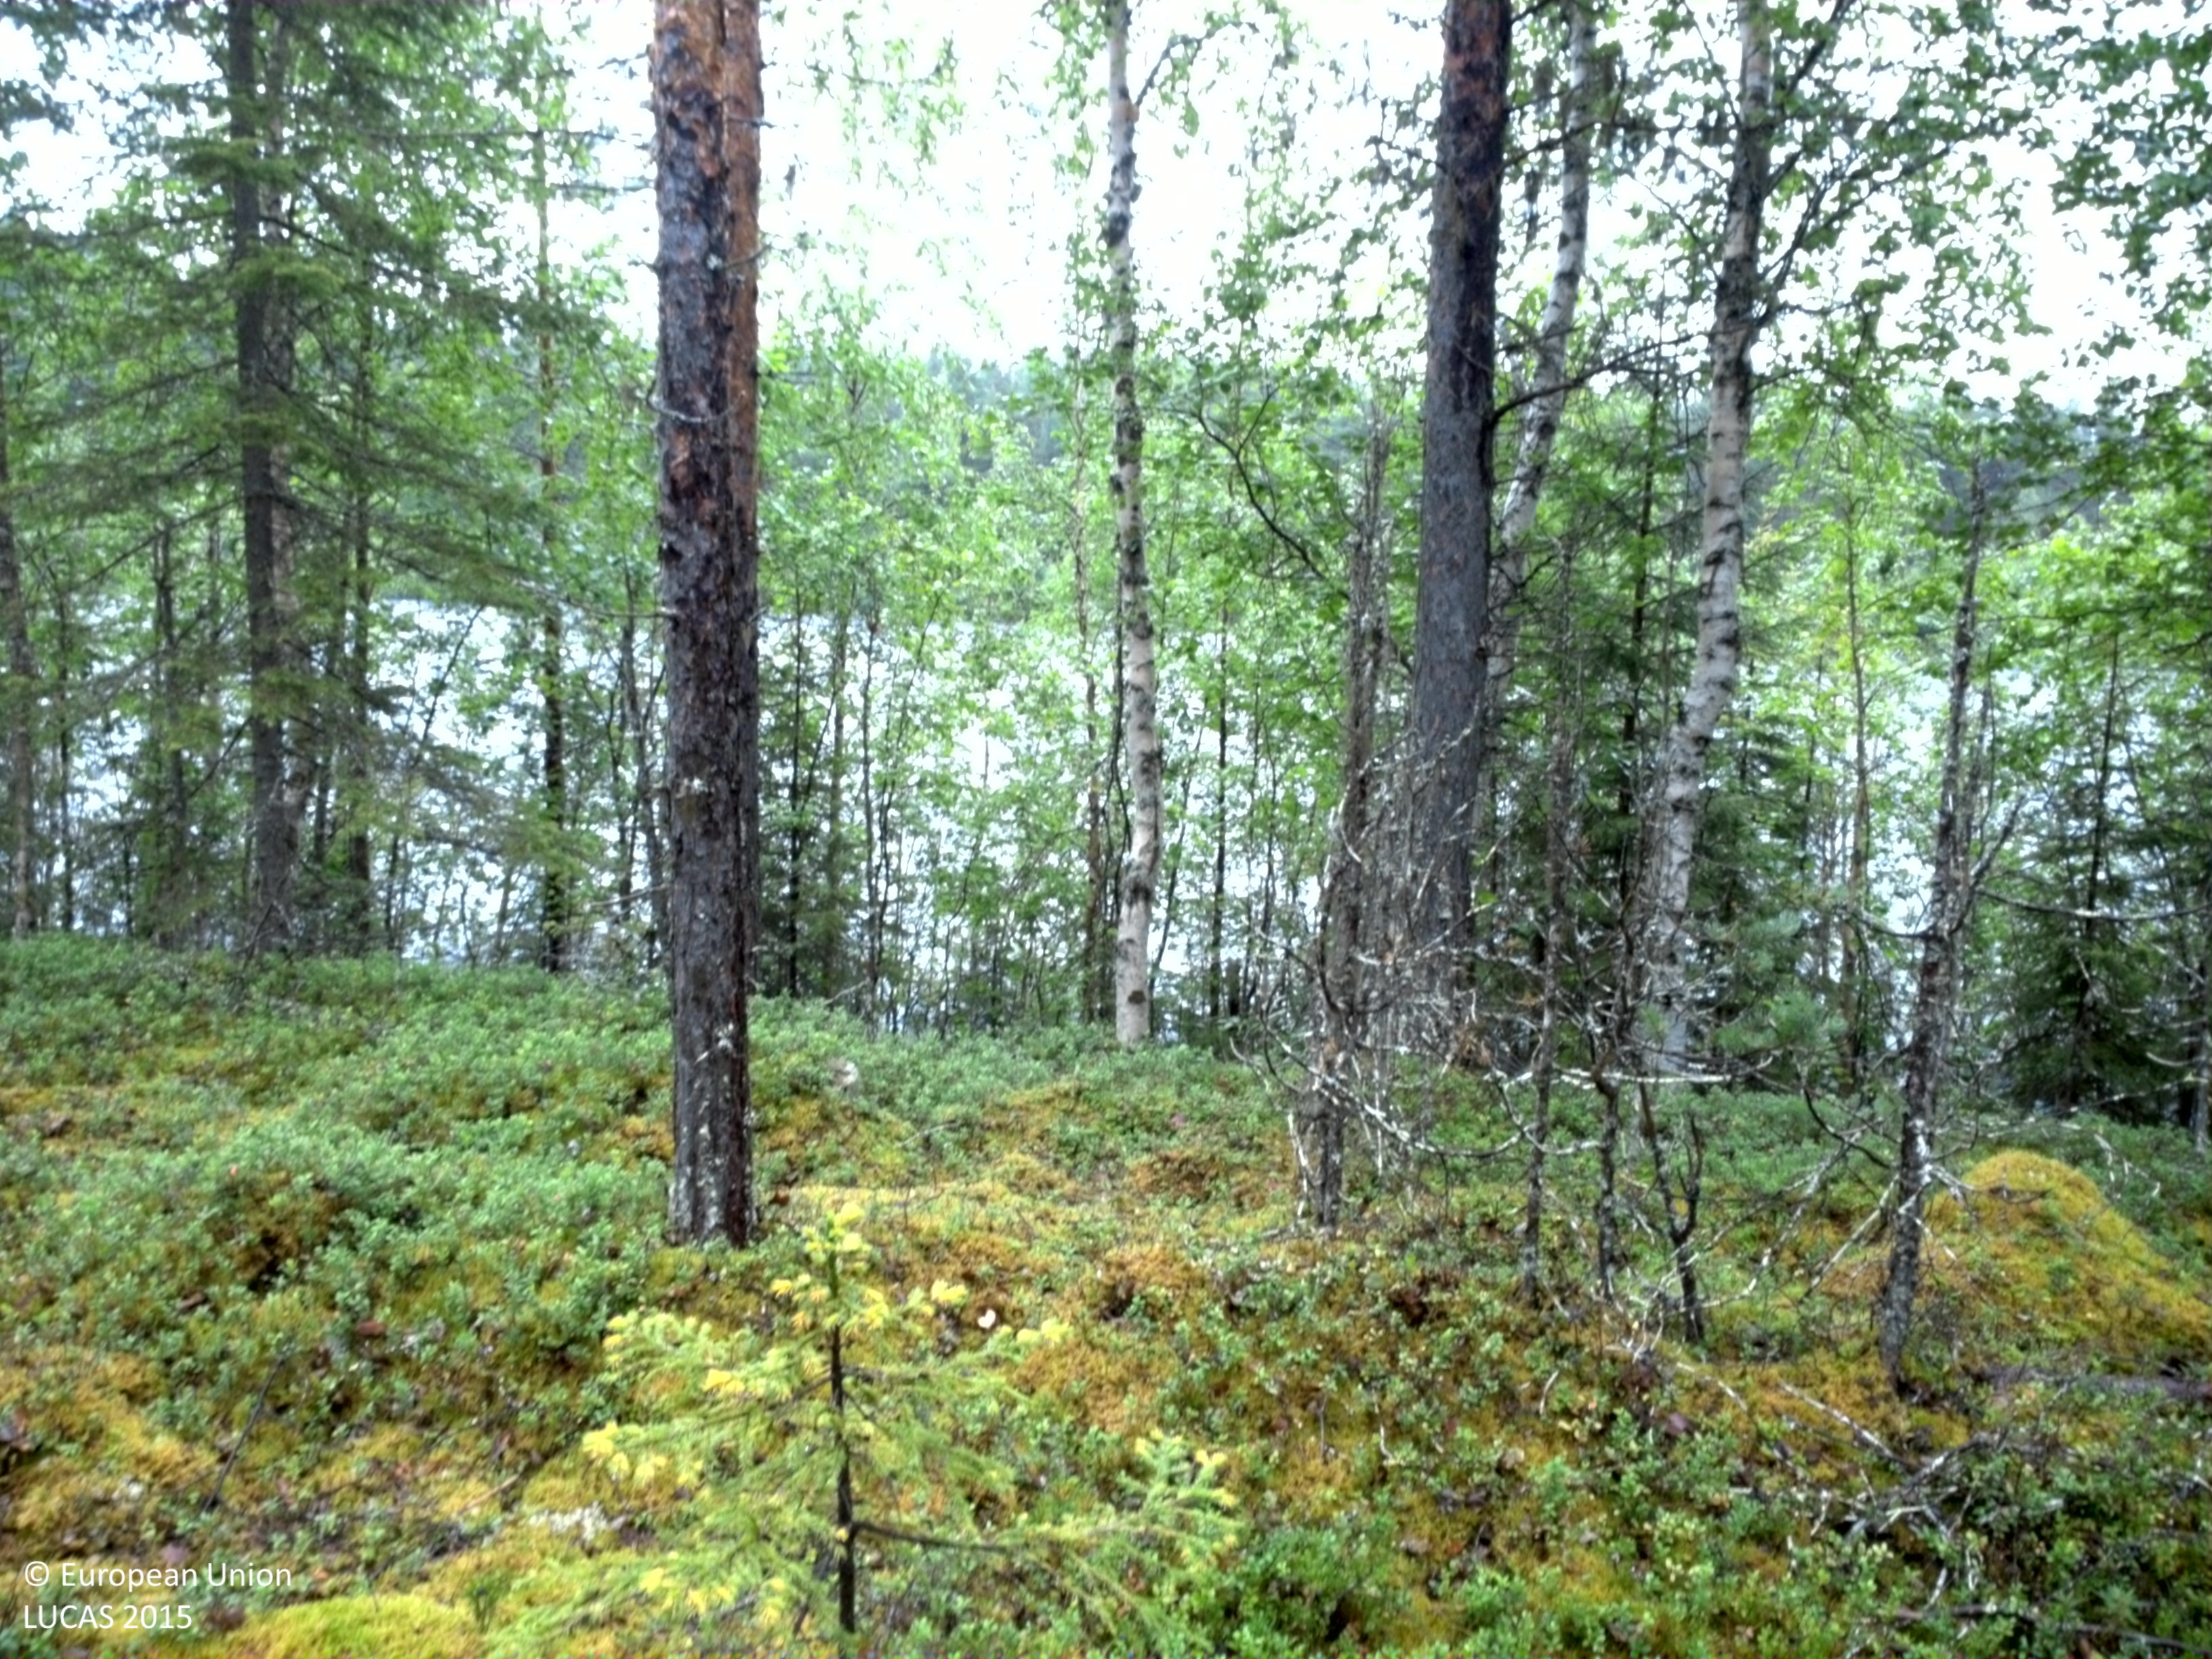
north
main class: Woodland
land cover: Pine dominated coniferous woodland
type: boreal forest
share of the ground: 25 - 50 %
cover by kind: shrubs 55 %, coniferous forest trees 35 %, broadleaved forest trees 5 %, lichens and mosses 5 %
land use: Forestry
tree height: > 5 m
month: August
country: SE
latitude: 66.4386
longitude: 20.5613
